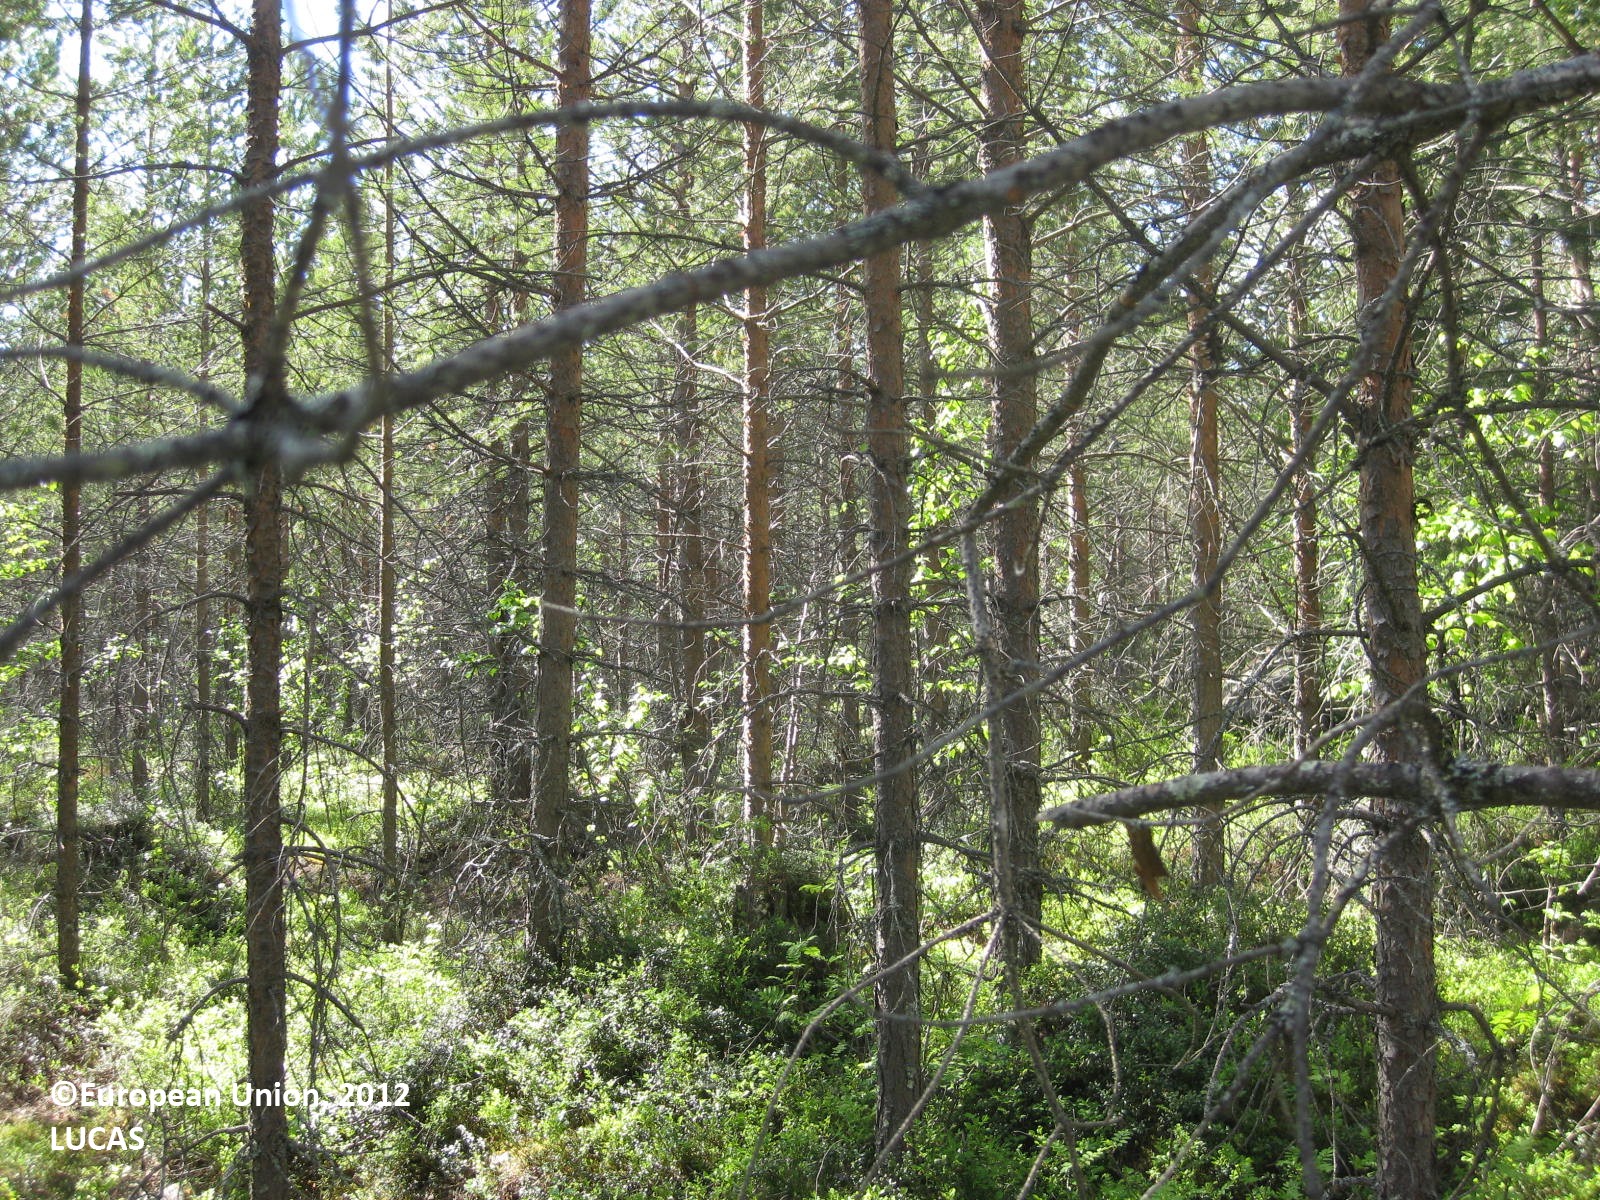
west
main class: Woodland
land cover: Pine dominated coniferous woodland
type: boreal forest
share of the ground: > 75 %
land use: Forestry
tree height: > 5 m
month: June
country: FI
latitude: 65.0340
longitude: 28.8010
